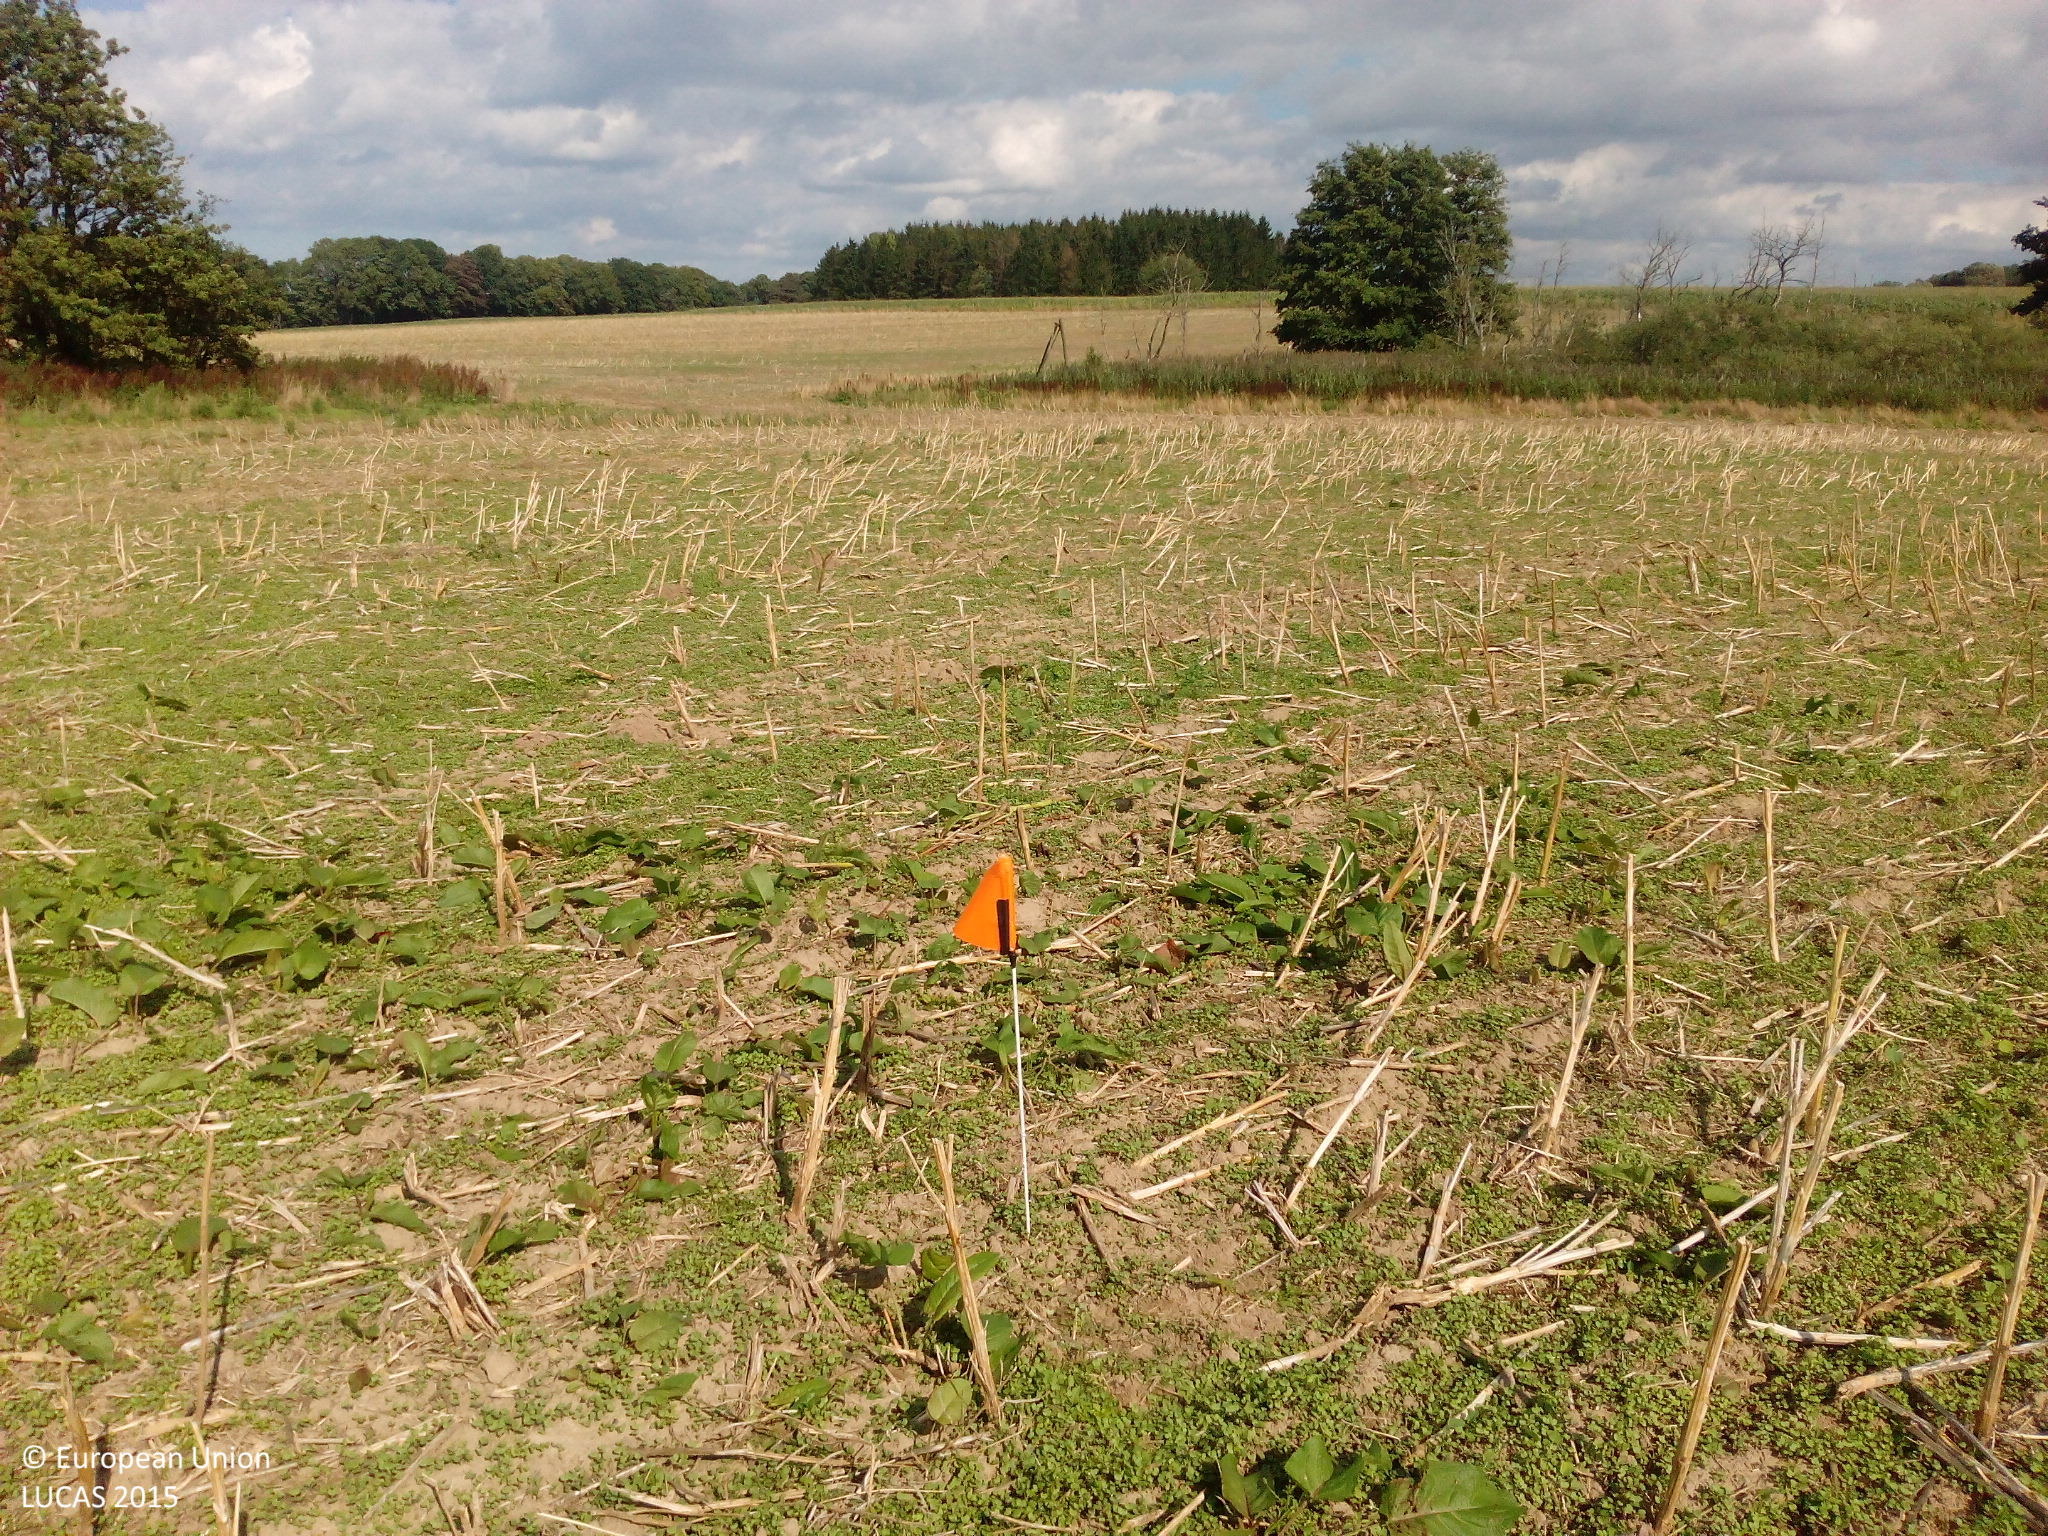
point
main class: Cropland
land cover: Rape and turnip rape
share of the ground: > 75 %
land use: Agriculture (excluding fallow land and kitchen gardens)
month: September
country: DE
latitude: 54.0447
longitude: 12.3357
